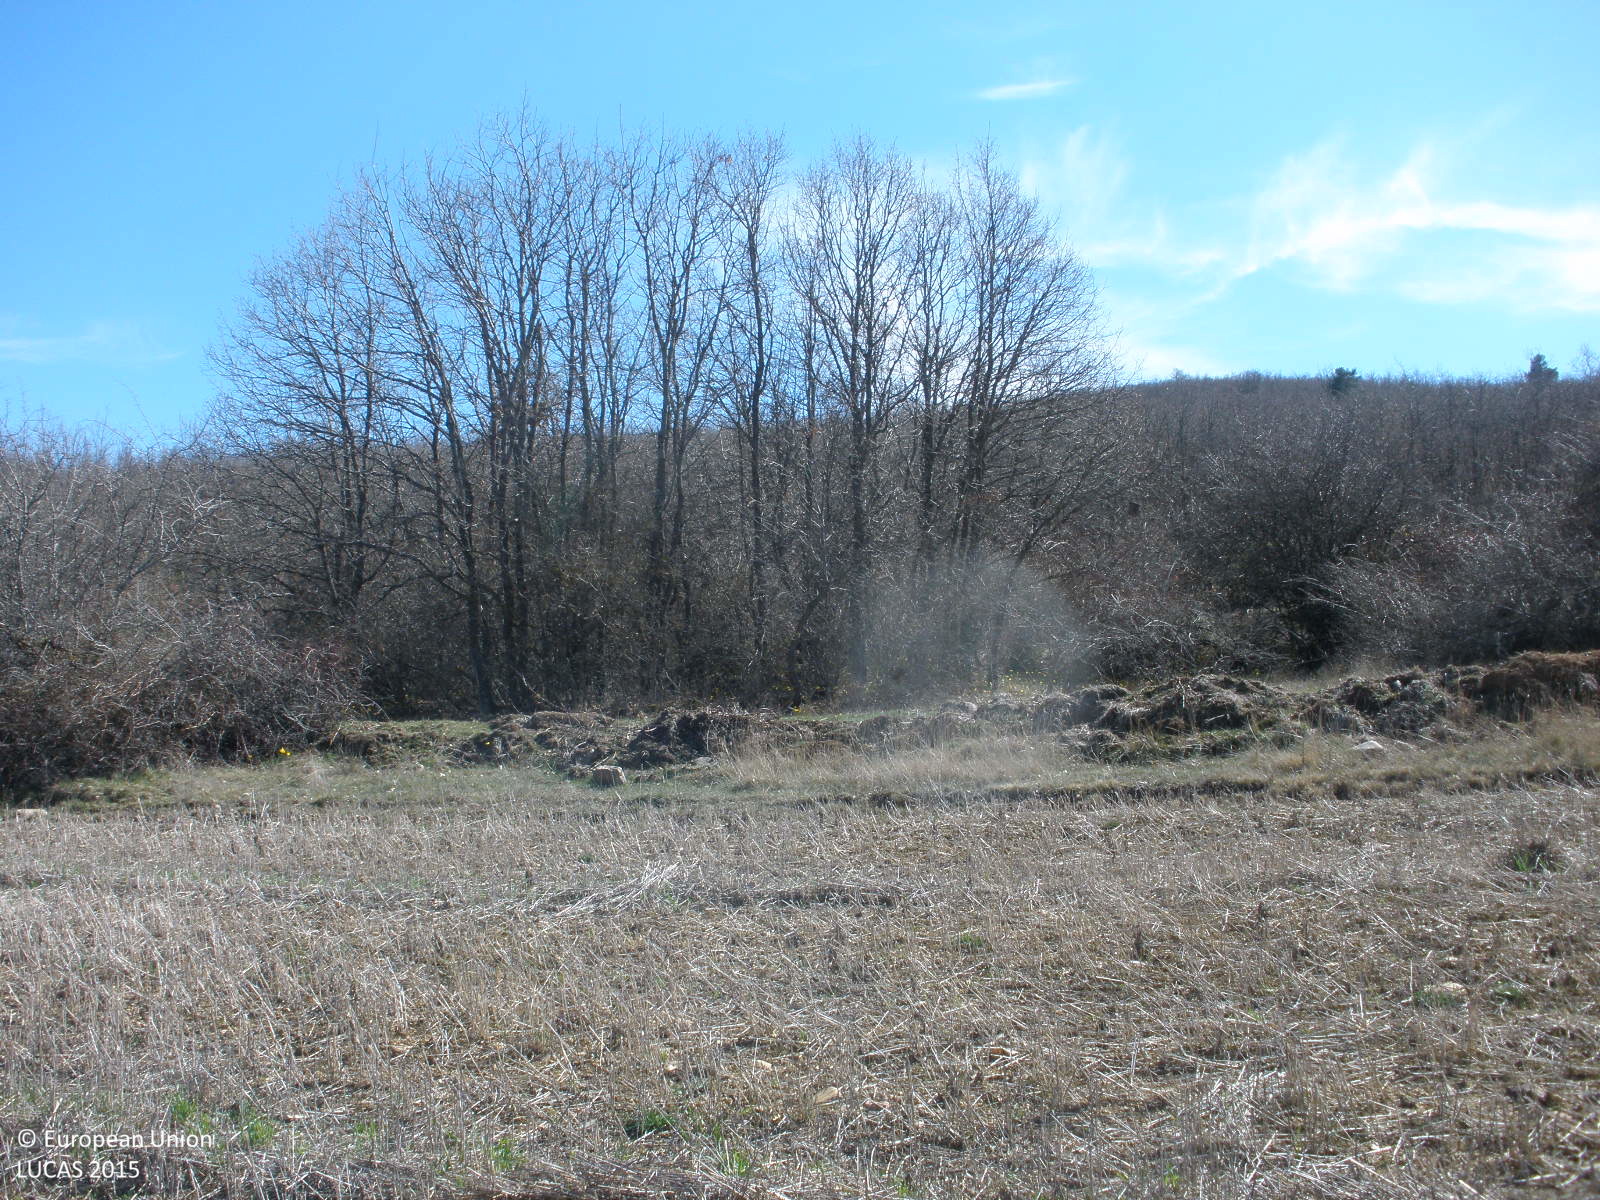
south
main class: Grassland
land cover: Spontaneously vegetated surfaces
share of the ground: 50 - 75 %
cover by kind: herbaceous plants 70 %, unconsolidated bare surface 30 %
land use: Agriculture (excluding fallow land and kitchen gardens)
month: April
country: ES
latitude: 40.9871
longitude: -1.0830
